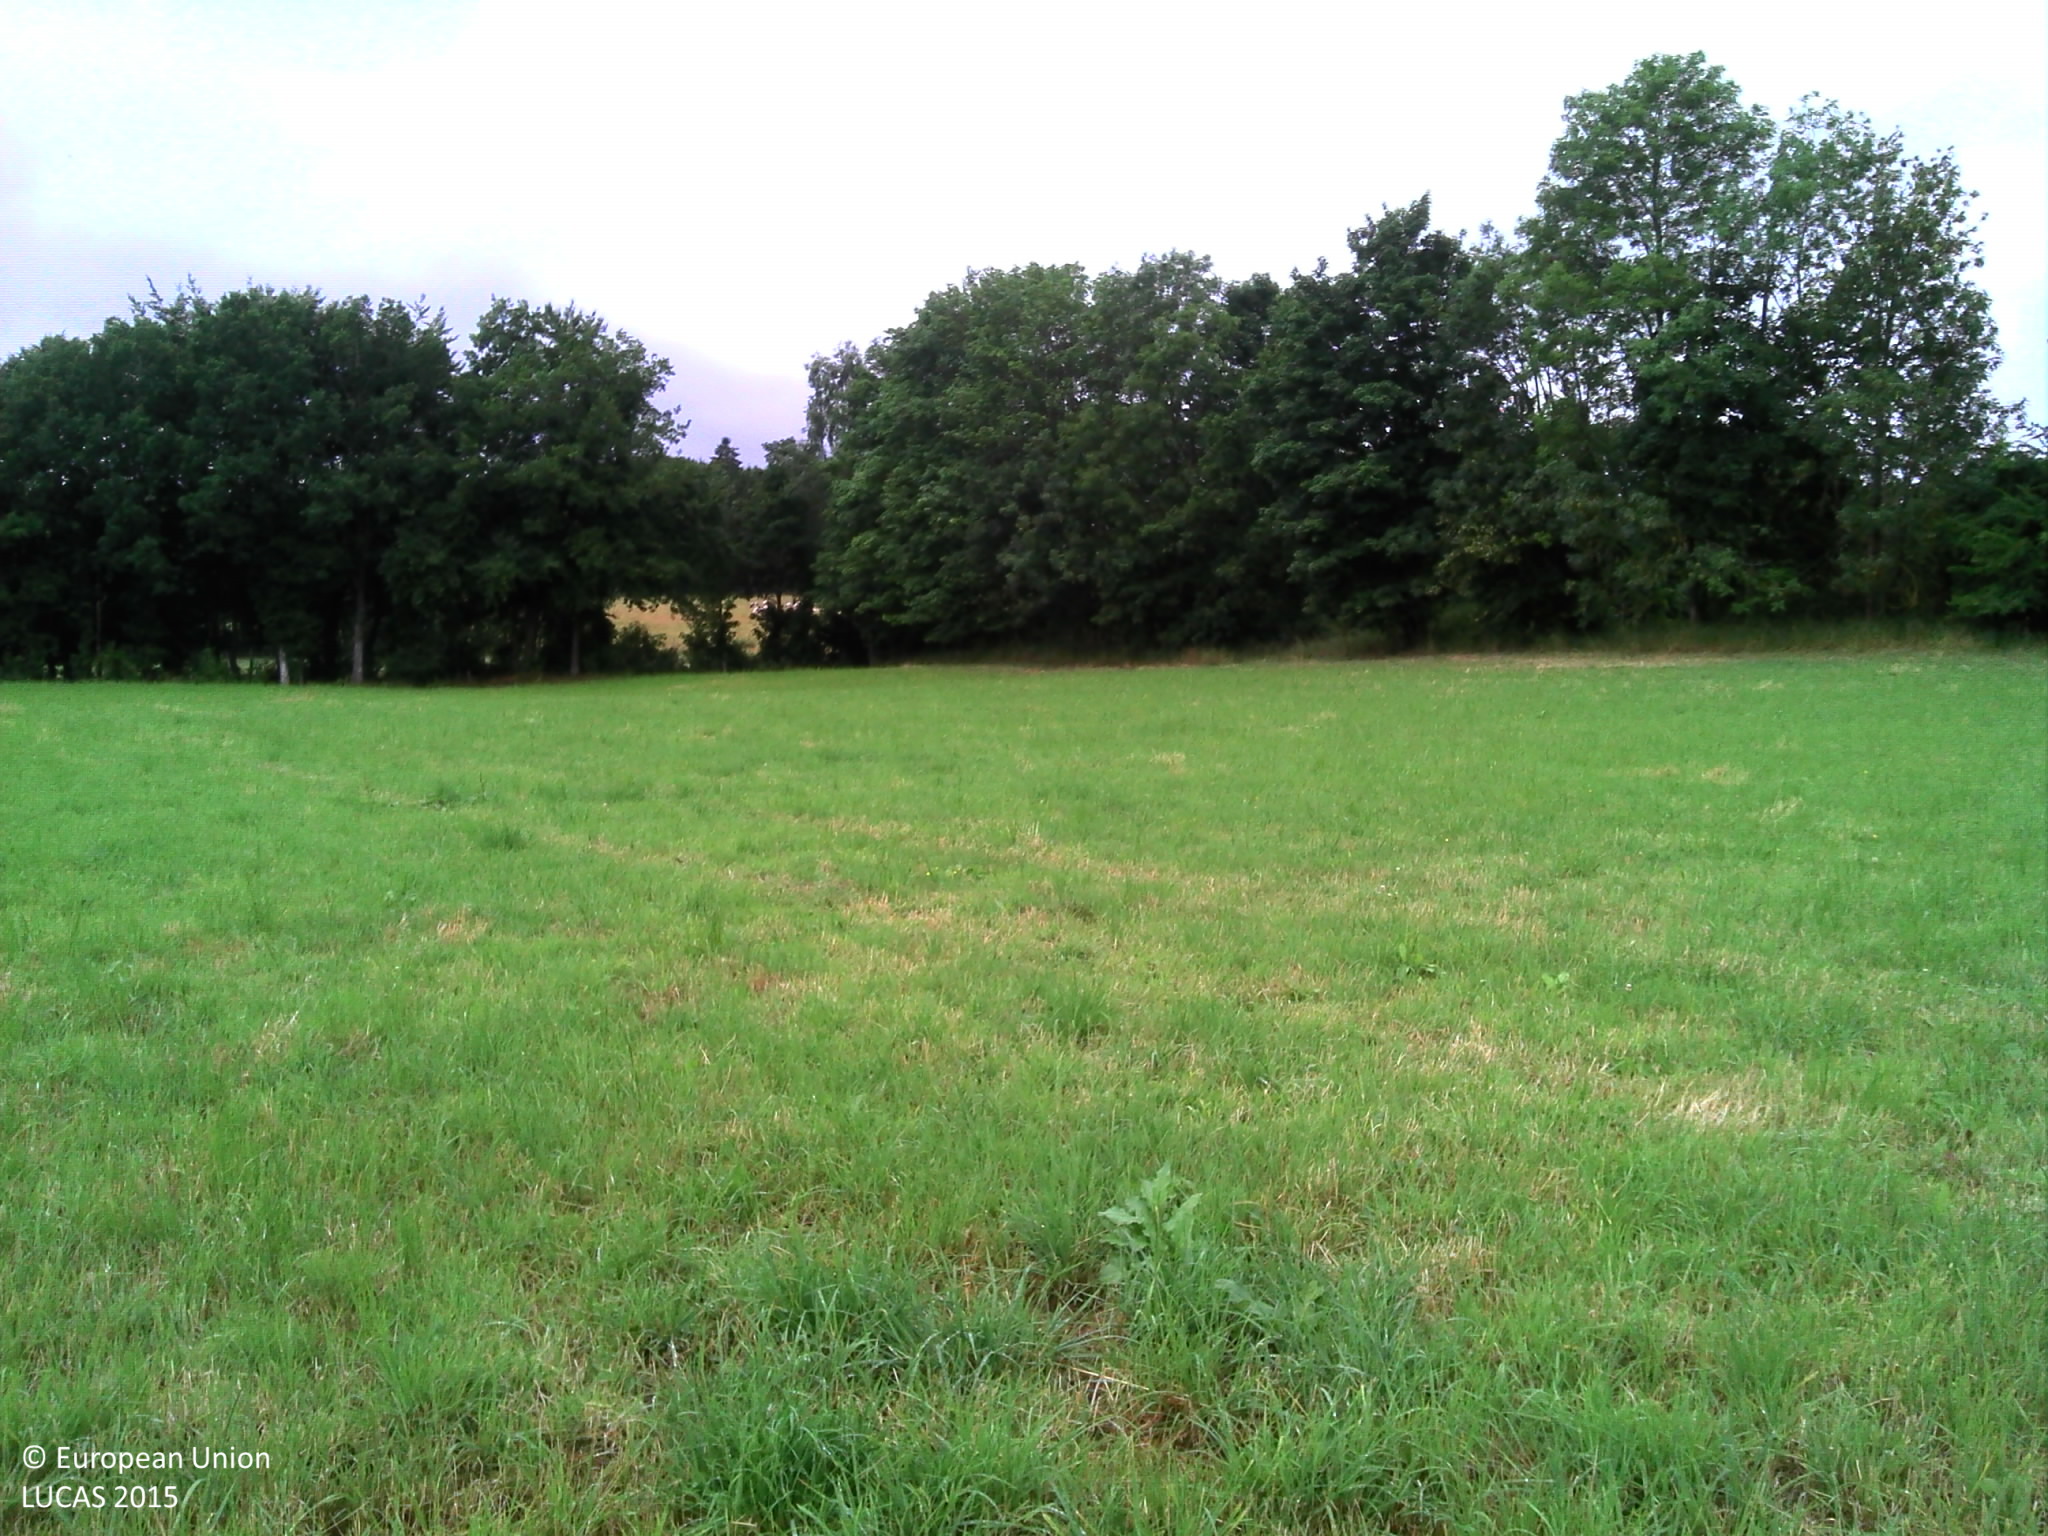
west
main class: Grassland
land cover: Grassland without tree/shrub cover
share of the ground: > 75 %
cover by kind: herbaceous plants 100 %
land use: Agriculture (excluding fallow land and kitchen gardens)
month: July
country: BE
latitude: 50.1065
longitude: 5.7902
